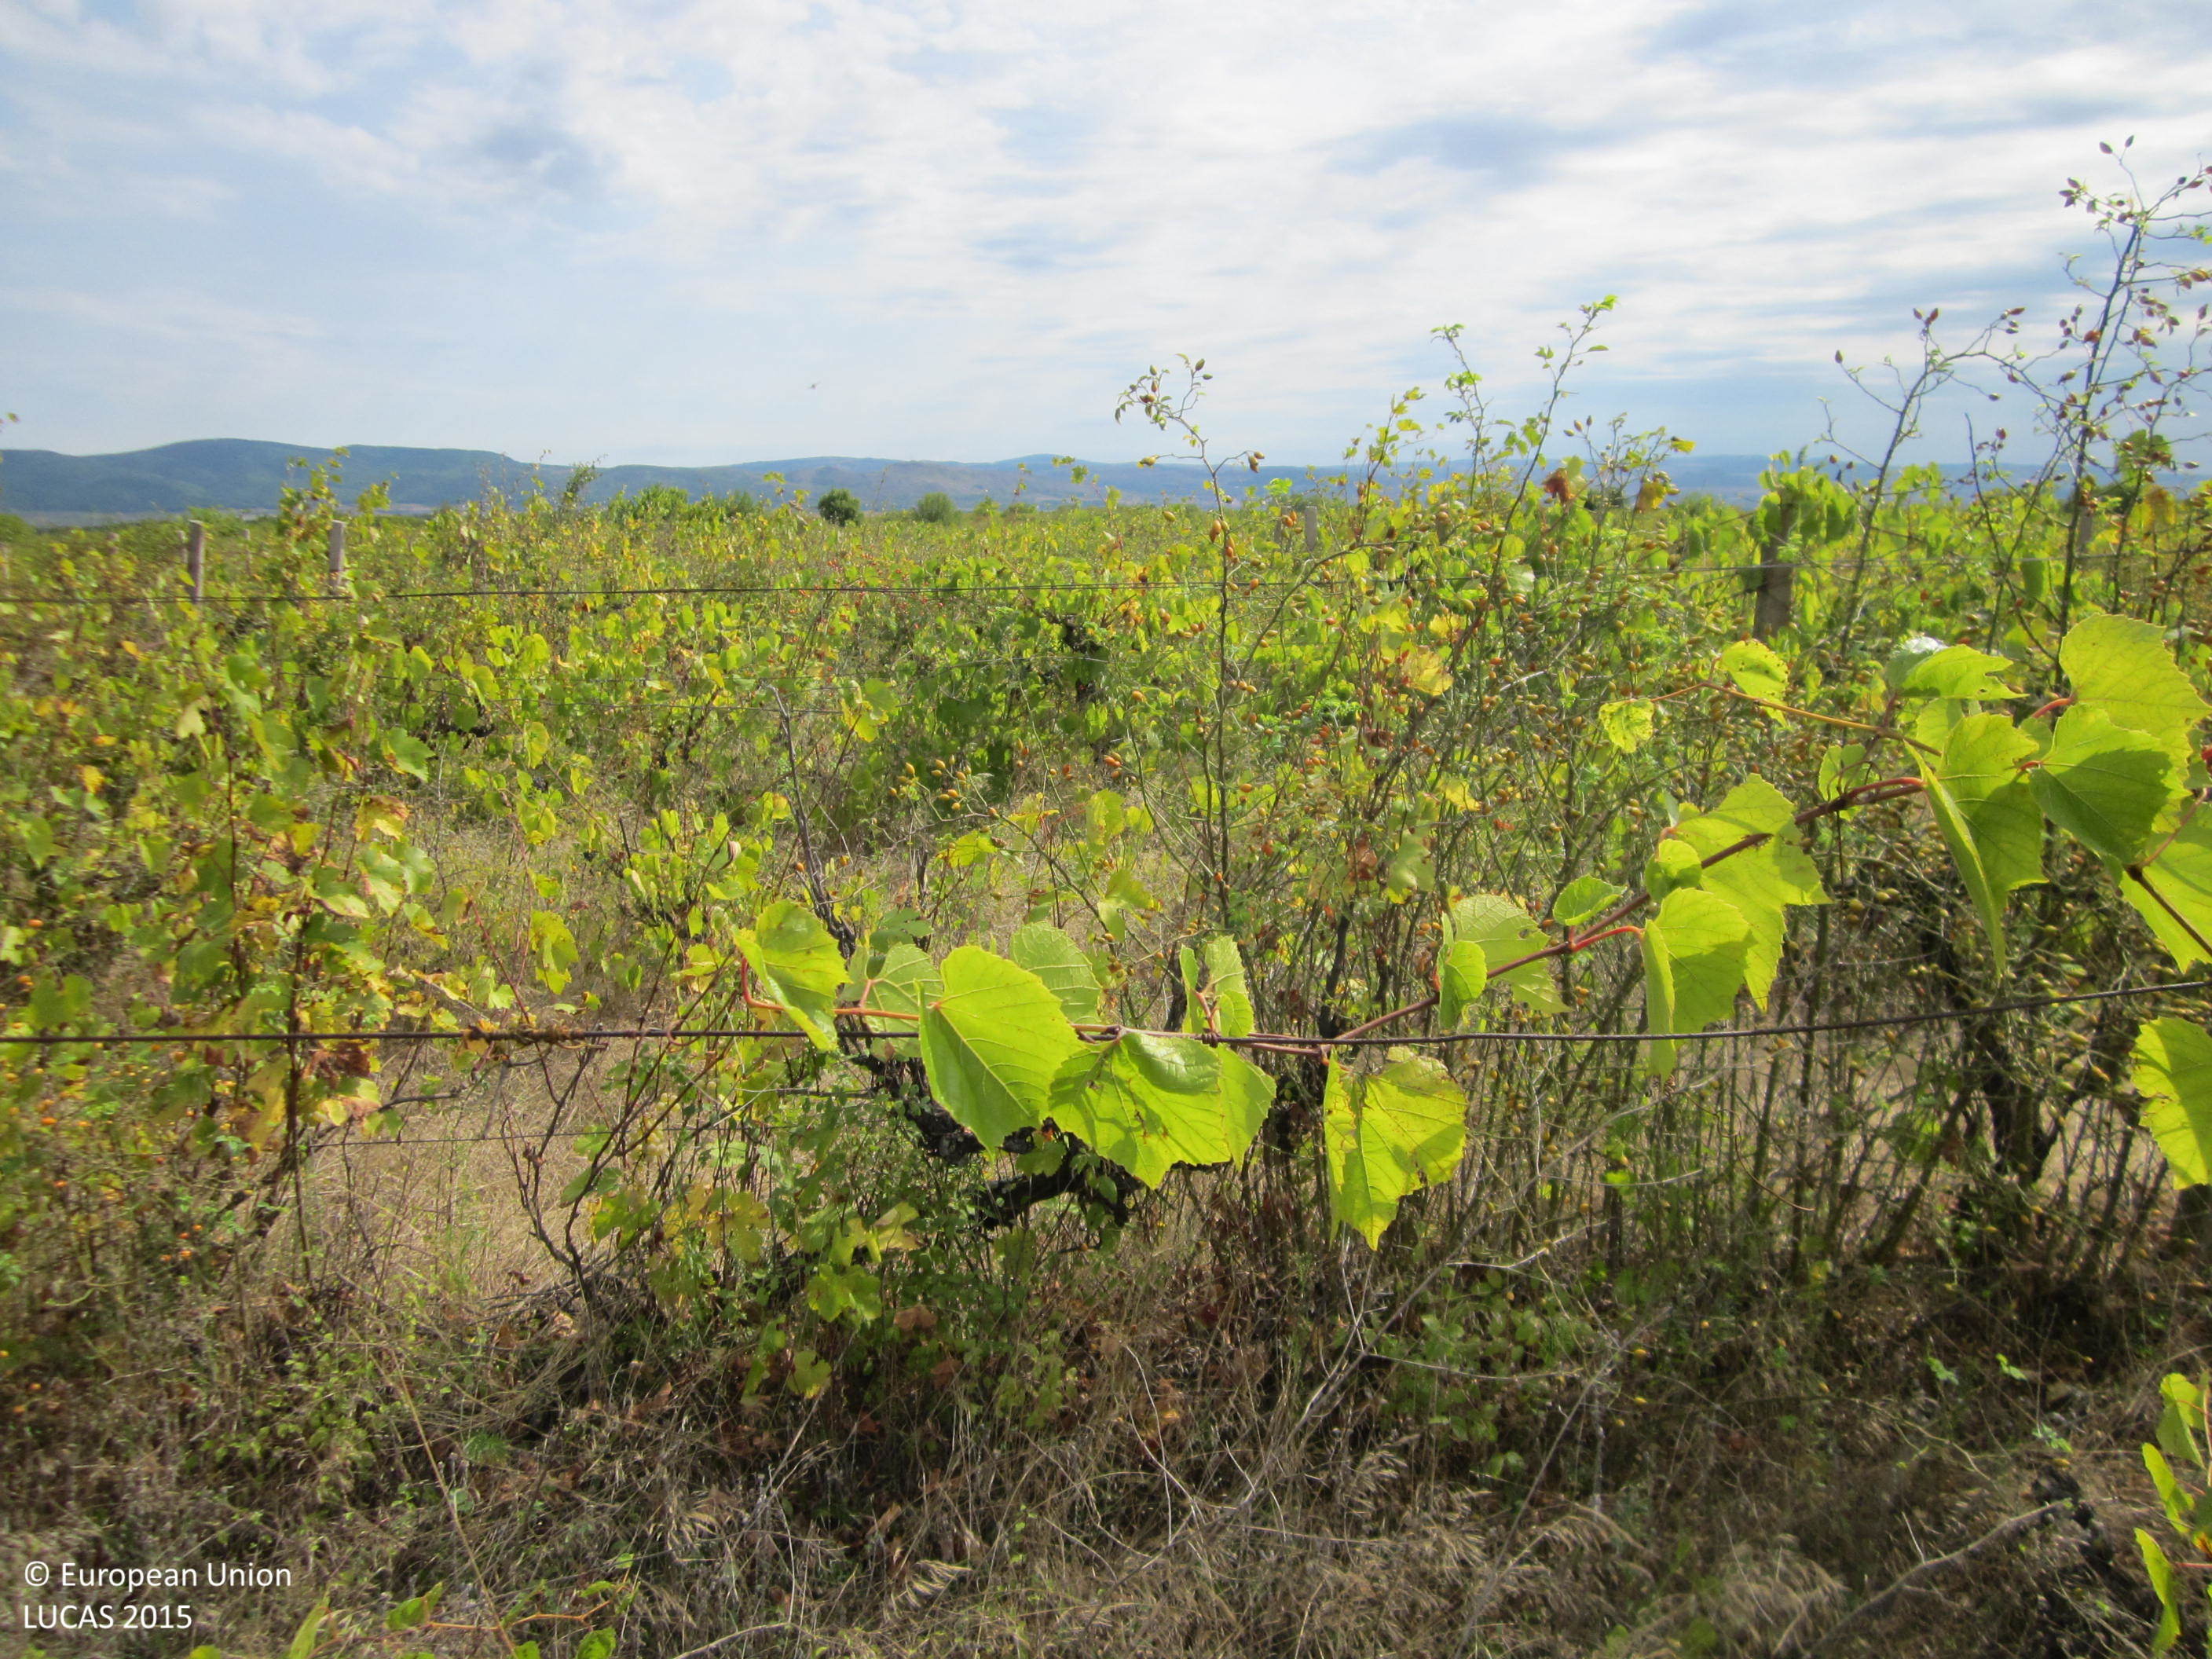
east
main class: Cropland
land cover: Vineyards
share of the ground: 50 - 75 %
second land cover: Spontaneously vegetated surfaces
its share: > 75 %
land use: Agriculture (excluding fallow land and kitchen gardens)
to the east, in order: Vineyards; Spontaneously vegetated surfaces; Tracks; Abandoned hedges; Vineyards
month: September
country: BG
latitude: 42.6908
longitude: 27.1377
